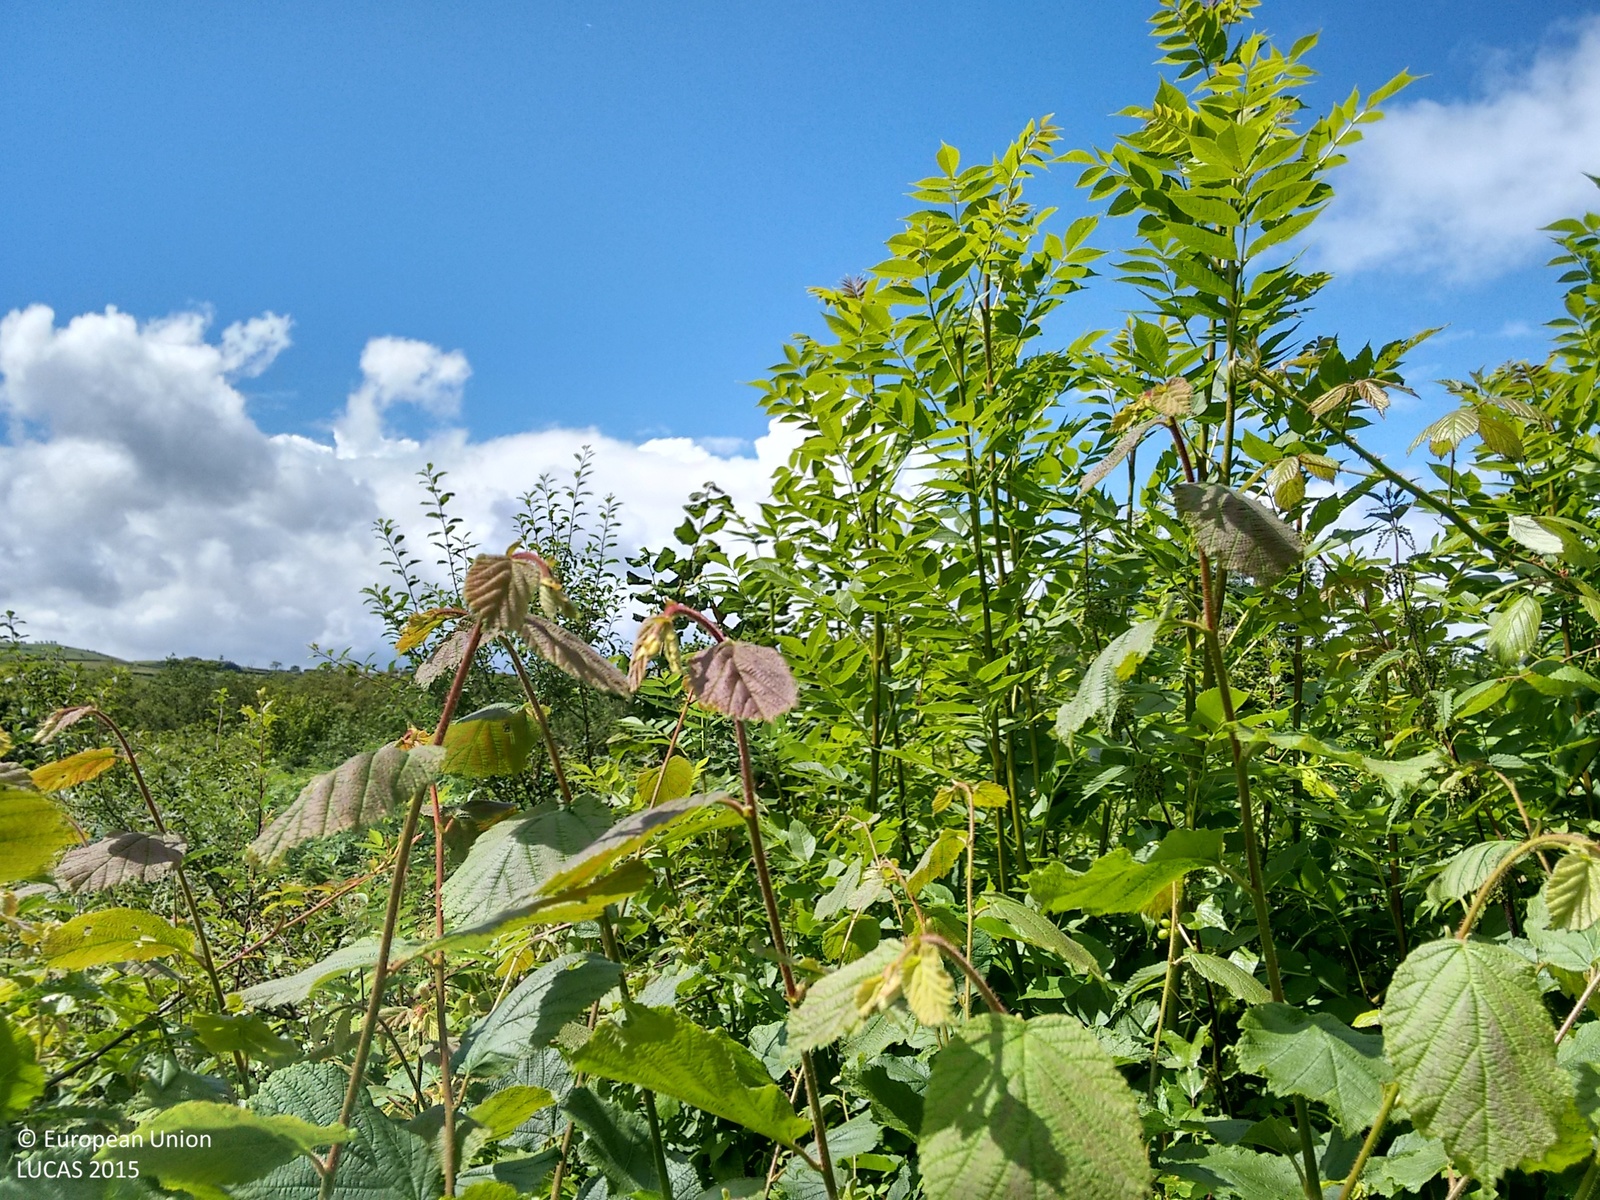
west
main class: Shrubland
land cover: Shrubland with sparse tree cover
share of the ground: > 75 %
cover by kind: shrubs 95 %, broadleaved forest trees 5 %
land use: Agriculture (excluding fallow land and kitchen gardens)
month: July
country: GB
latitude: 51.8472
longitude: -4.0458
